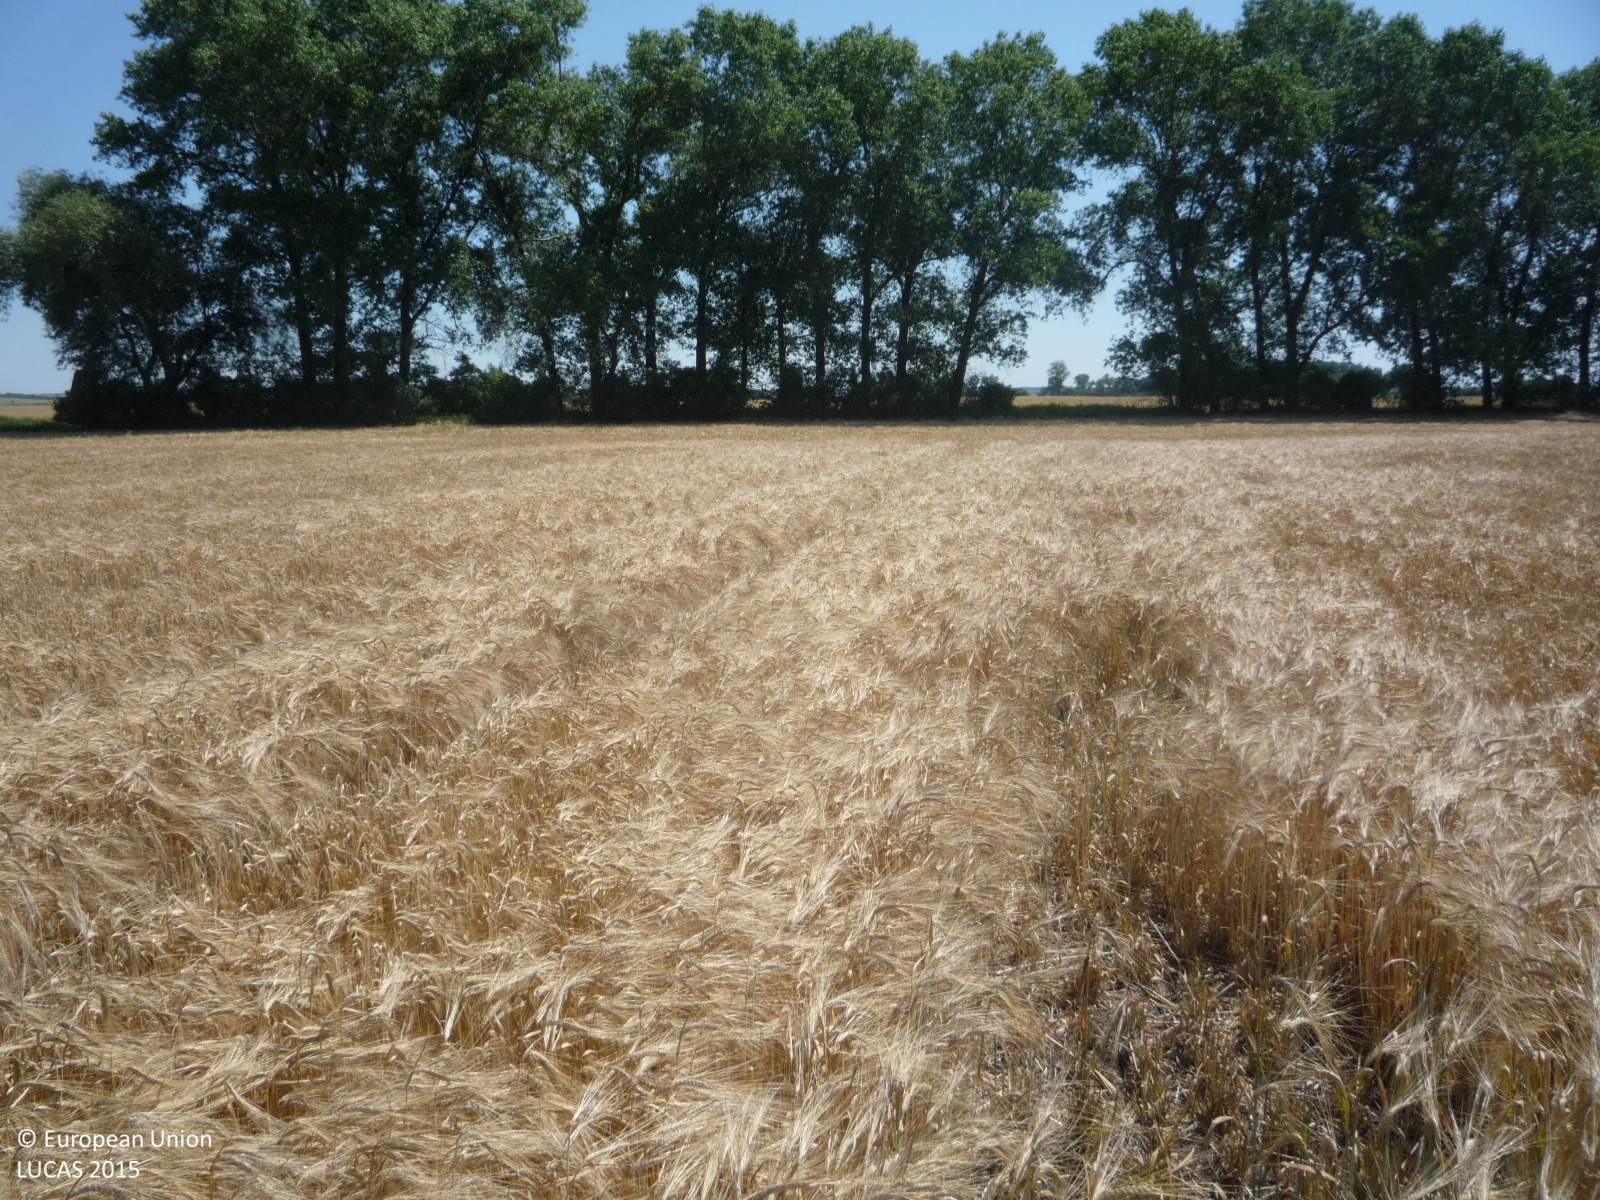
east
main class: Cropland
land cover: Barley
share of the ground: > 75 %
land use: Agriculture (excluding fallow land and kitchen gardens)
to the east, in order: Barley; Broadleaved woodland; Tracks; Barley
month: July
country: CZ
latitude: 50.2289
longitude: 15.1759
